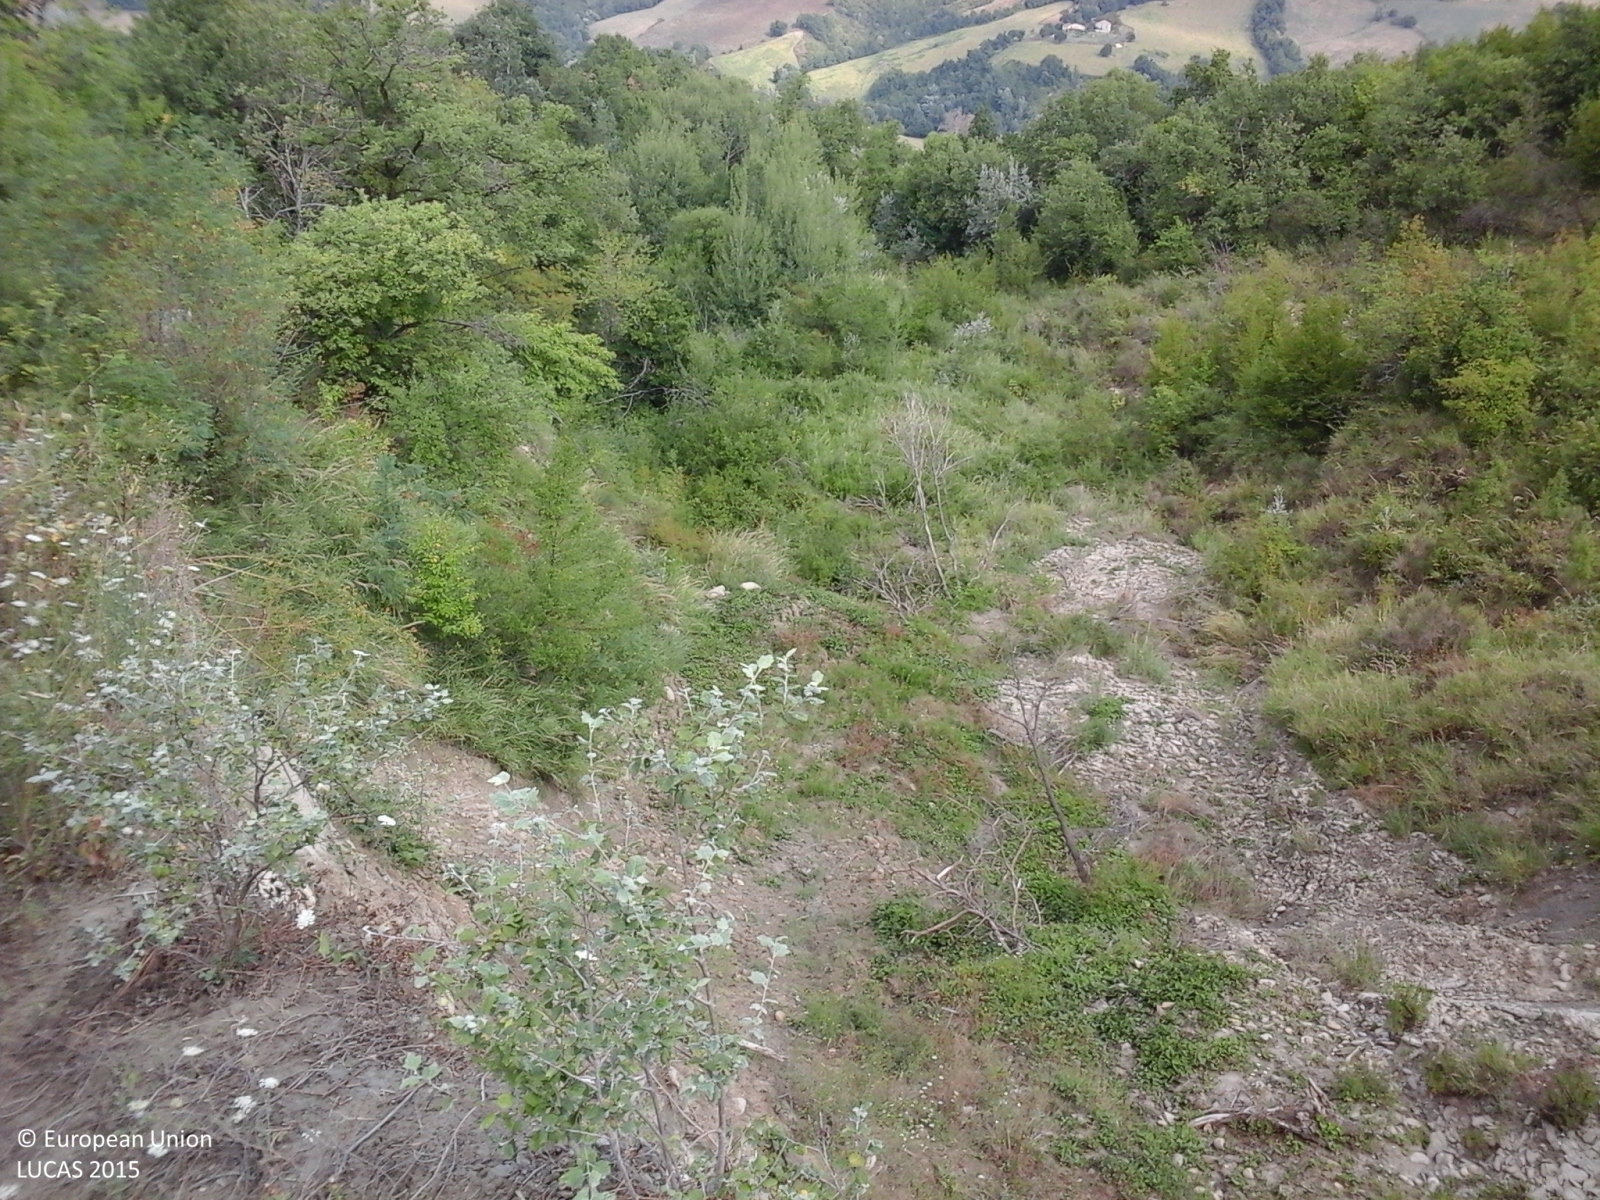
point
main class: Shrubland
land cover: Shrubland without tree cover
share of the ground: > 75 %
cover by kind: shrubs 100 %
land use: Semi-natural and natural areas not in use
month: August
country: IT
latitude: 43.0114
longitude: 13.4381
